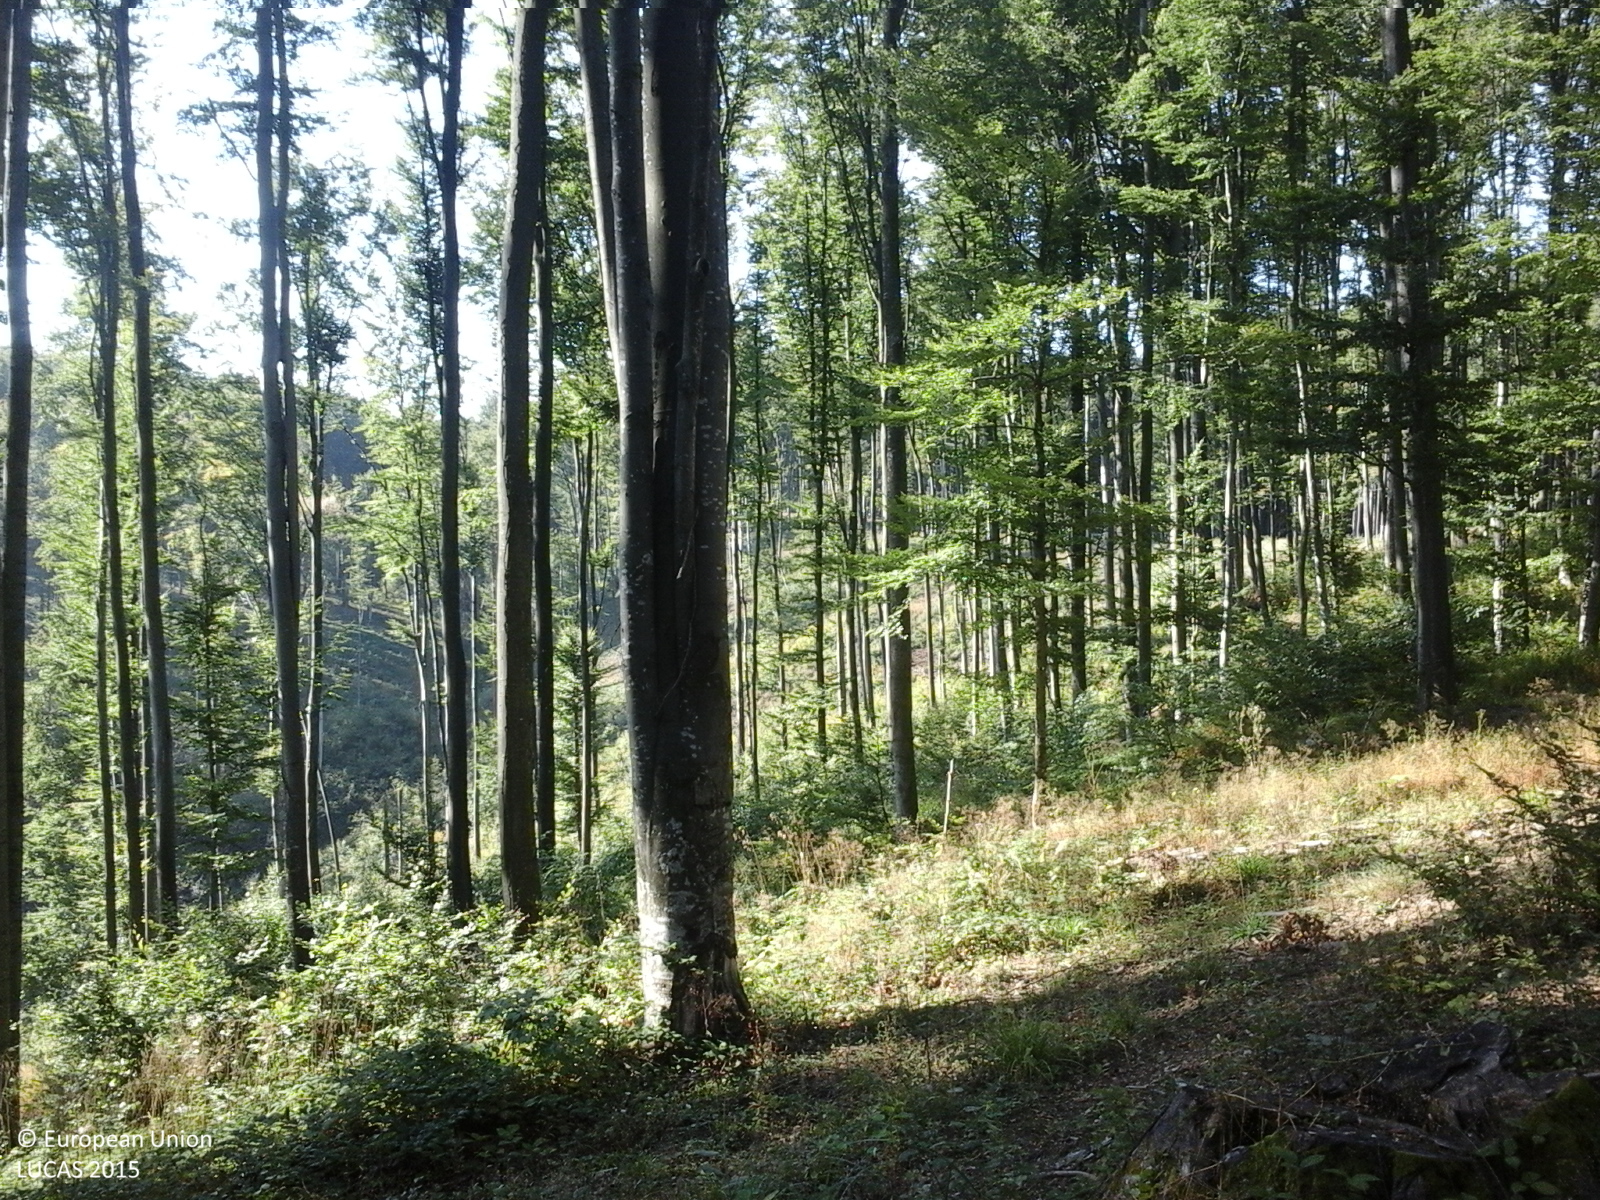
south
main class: Woodland
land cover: Broadleaved woodland
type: beech forest
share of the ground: > 75 %
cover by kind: broadleaved forest trees 100 %
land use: Forestry
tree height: > 5 m
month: September
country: RO
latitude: 47.1310
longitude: 22.4599
